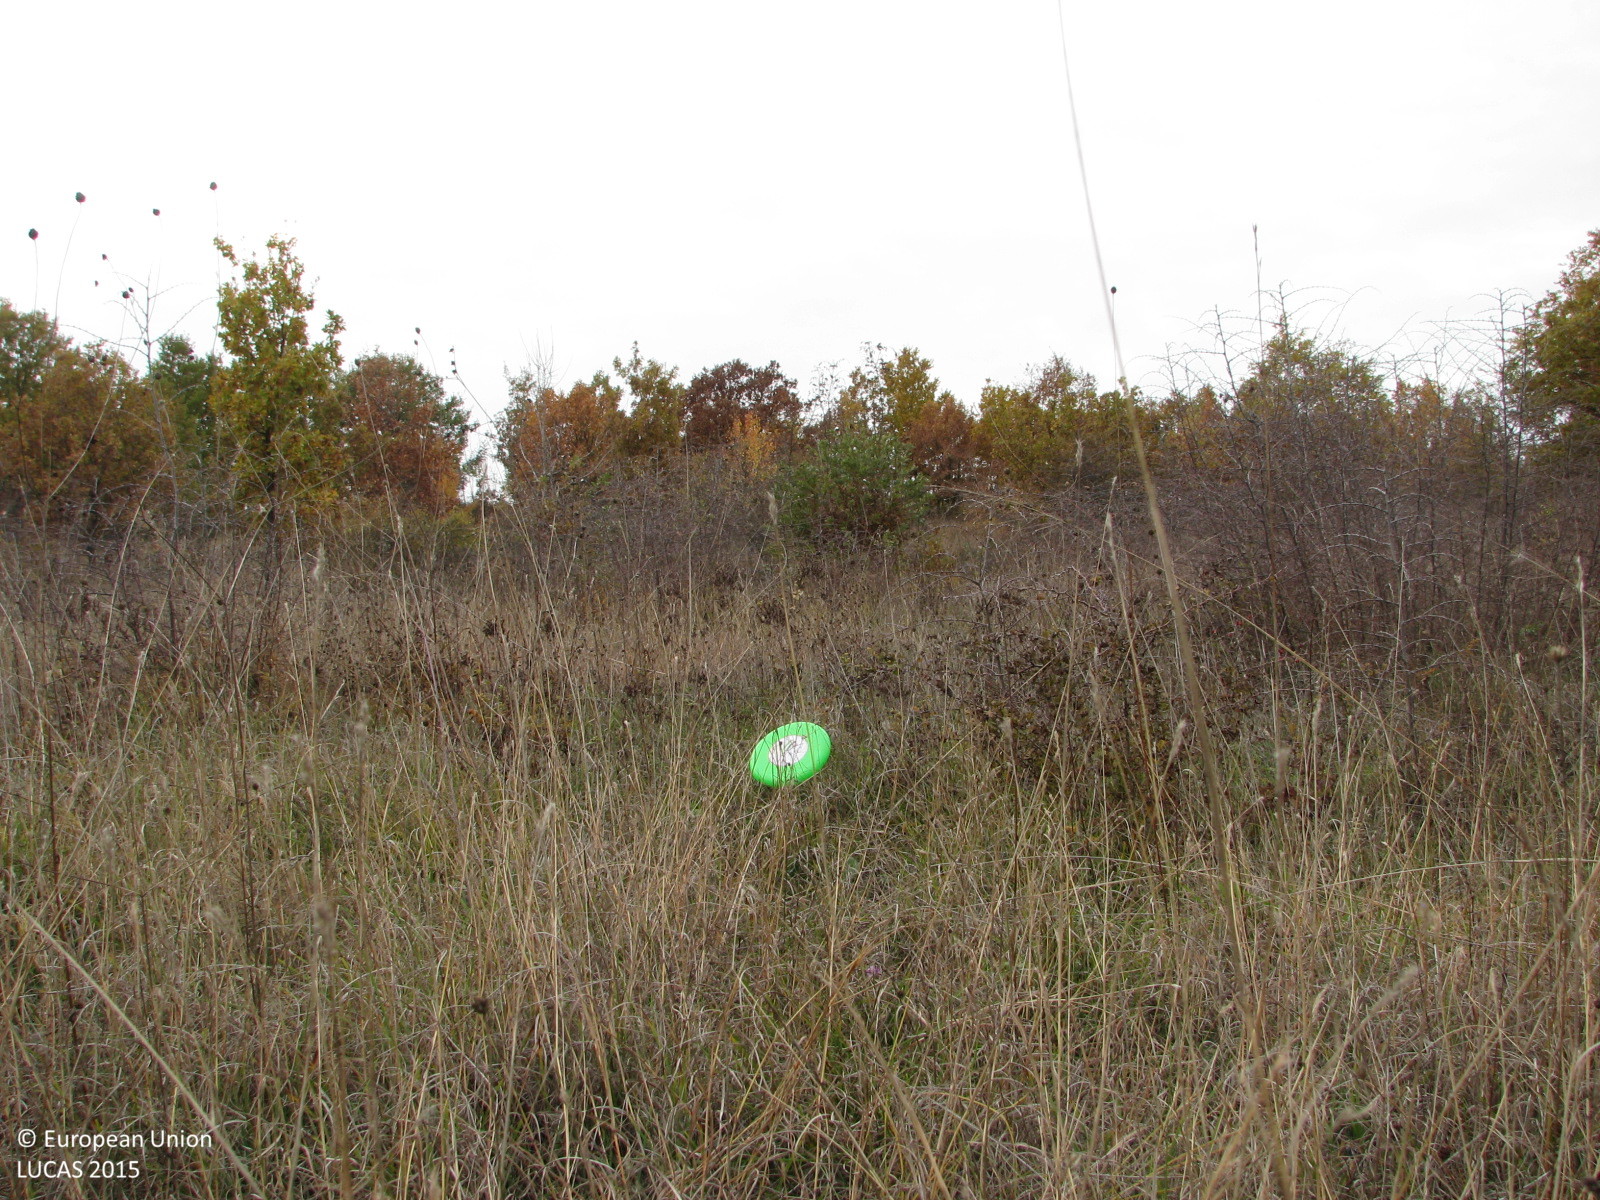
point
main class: Grassland
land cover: Grassland with sparse tree/shrub cover
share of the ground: > 75 %
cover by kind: herbaceous plants 90 %, broadleaved forest trees 5 %, shrubs 5 %
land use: Agriculture (excluding fallow land and kitchen gardens)
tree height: < 5 m
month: November
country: BG
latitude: 42.0551
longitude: 26.4335
